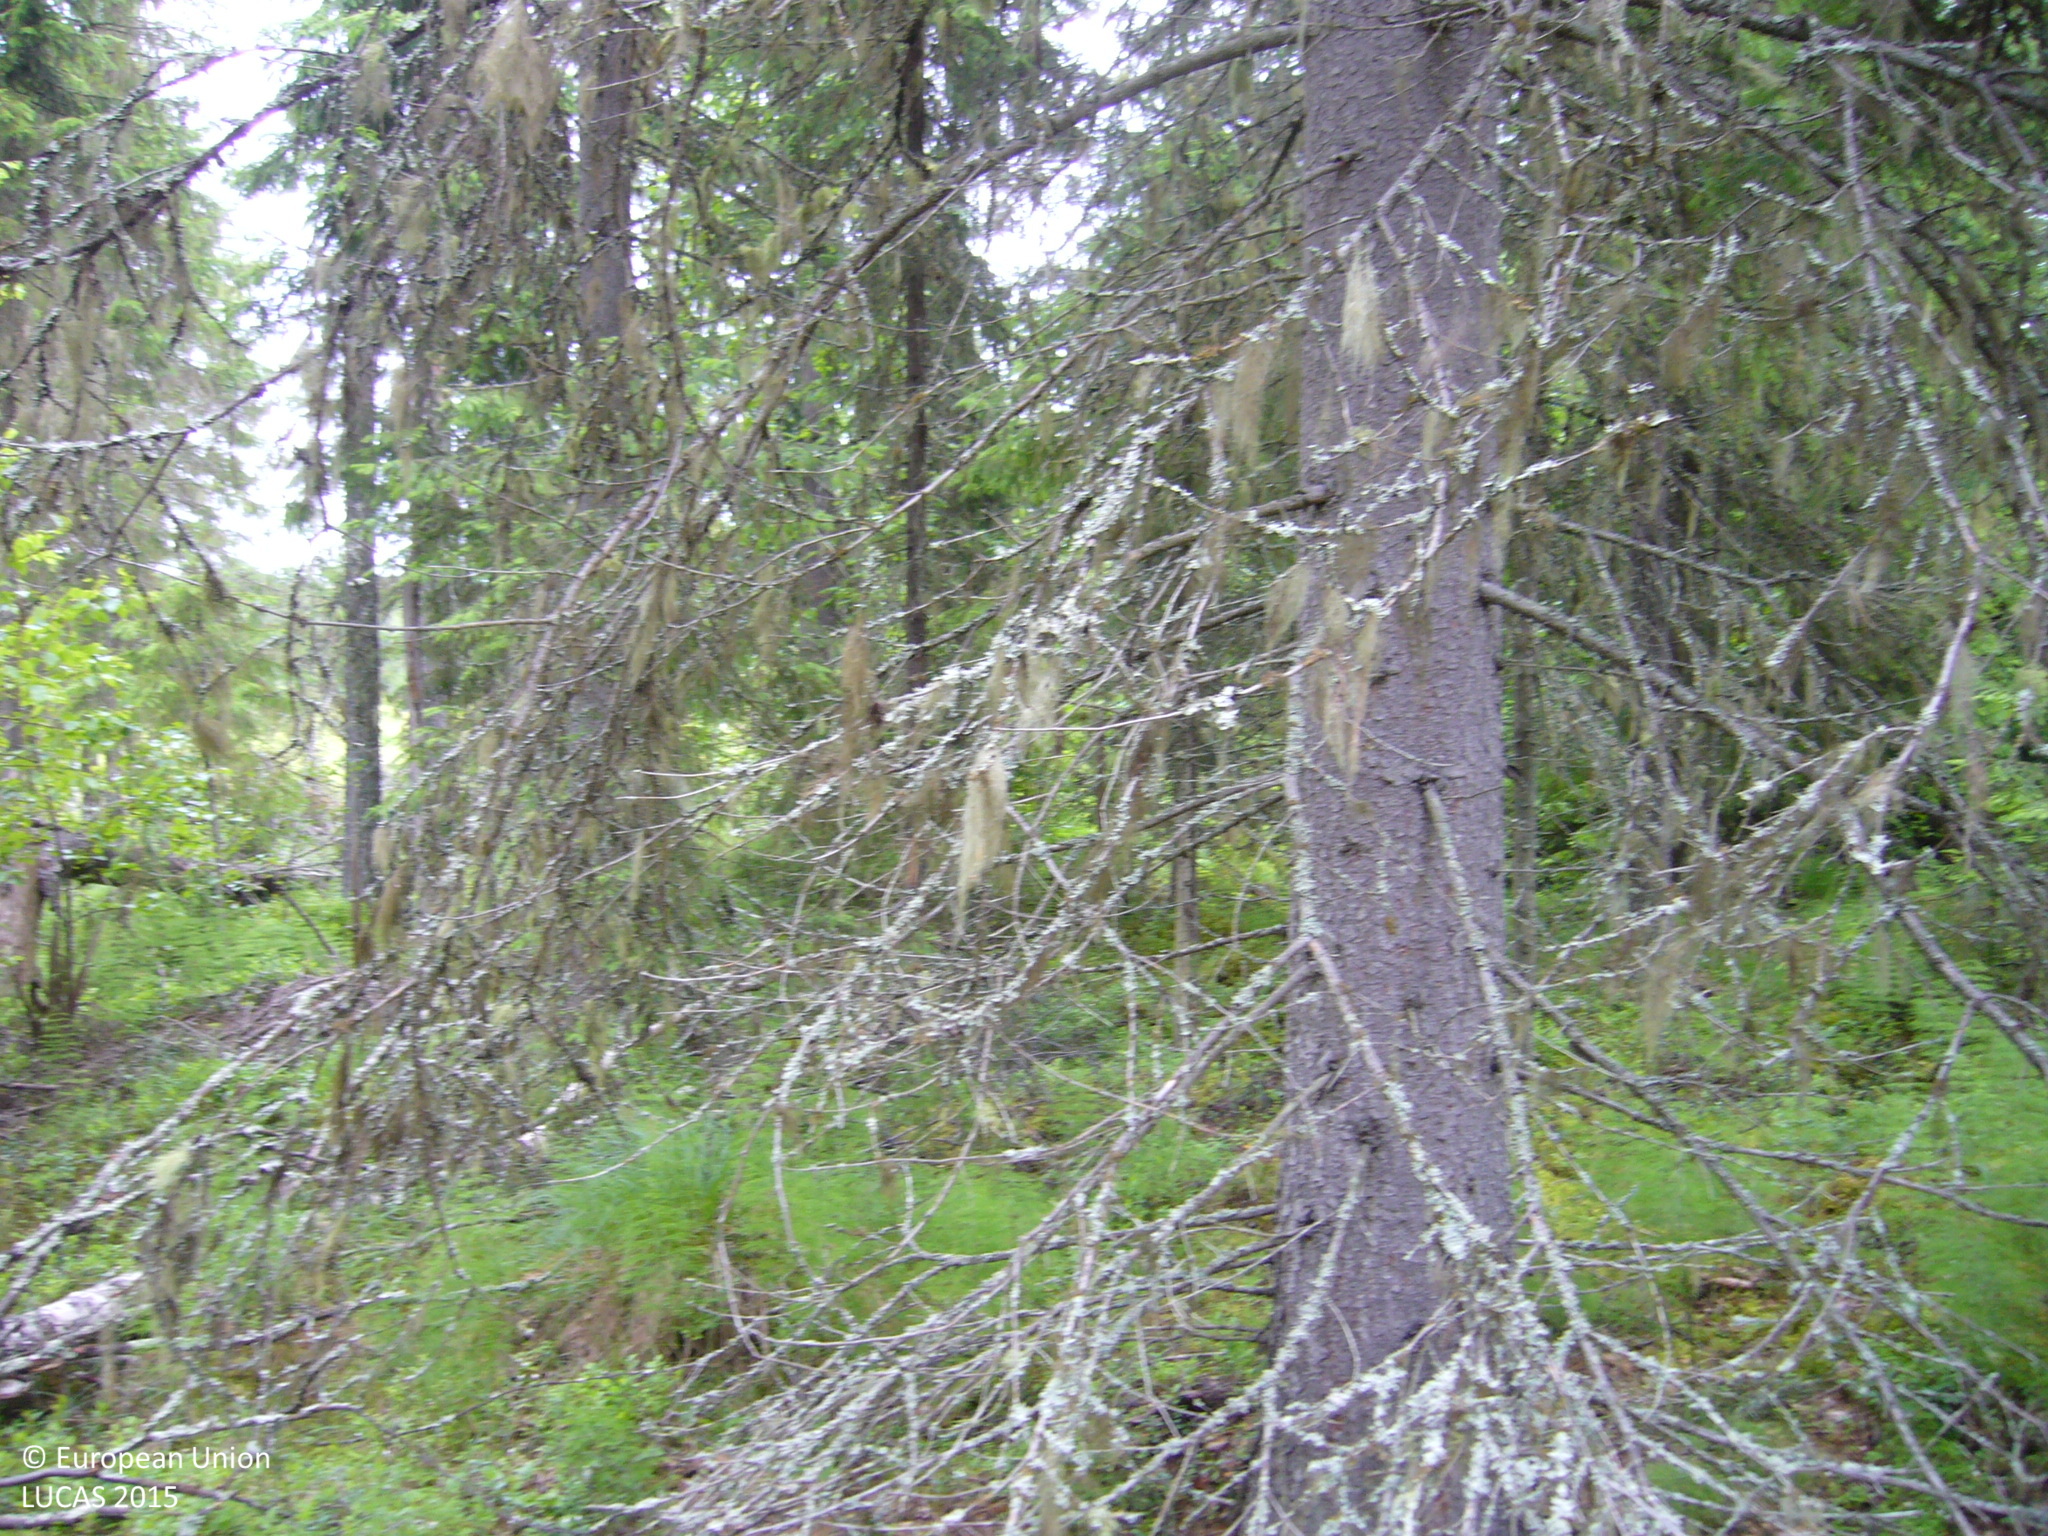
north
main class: Woodland
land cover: Spruce dominated coniferous woodland
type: boreal forest
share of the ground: 50 - 75 %
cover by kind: coniferous forest trees 40 %, shrubs 40 %, broadleaved forest trees 10 %, lichens and mosses 10 %
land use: Forestry
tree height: > 5 m
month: July
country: FI
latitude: 63.3436
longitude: 25.5887
